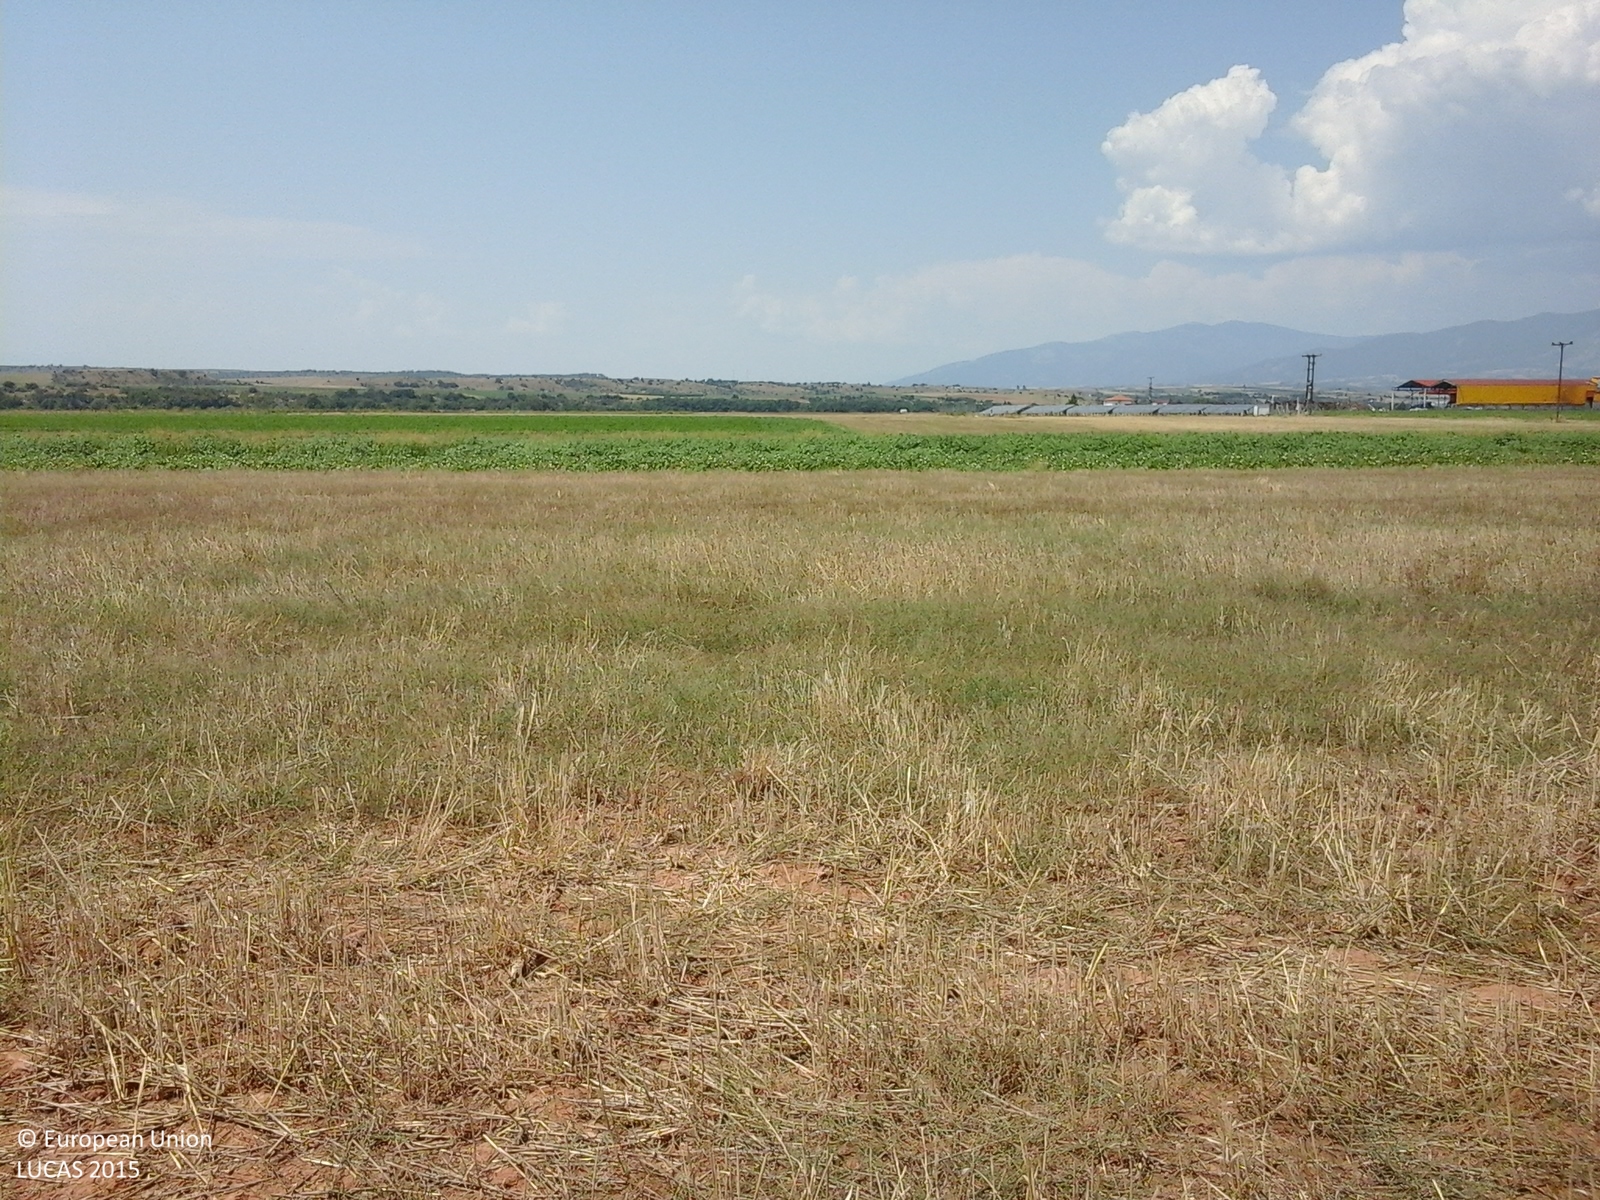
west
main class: Cropland
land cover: Common wheat
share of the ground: > 75 %
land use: Agriculture (excluding fallow land and kitchen gardens)
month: August
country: GR
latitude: 40.8453
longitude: 22.5659
